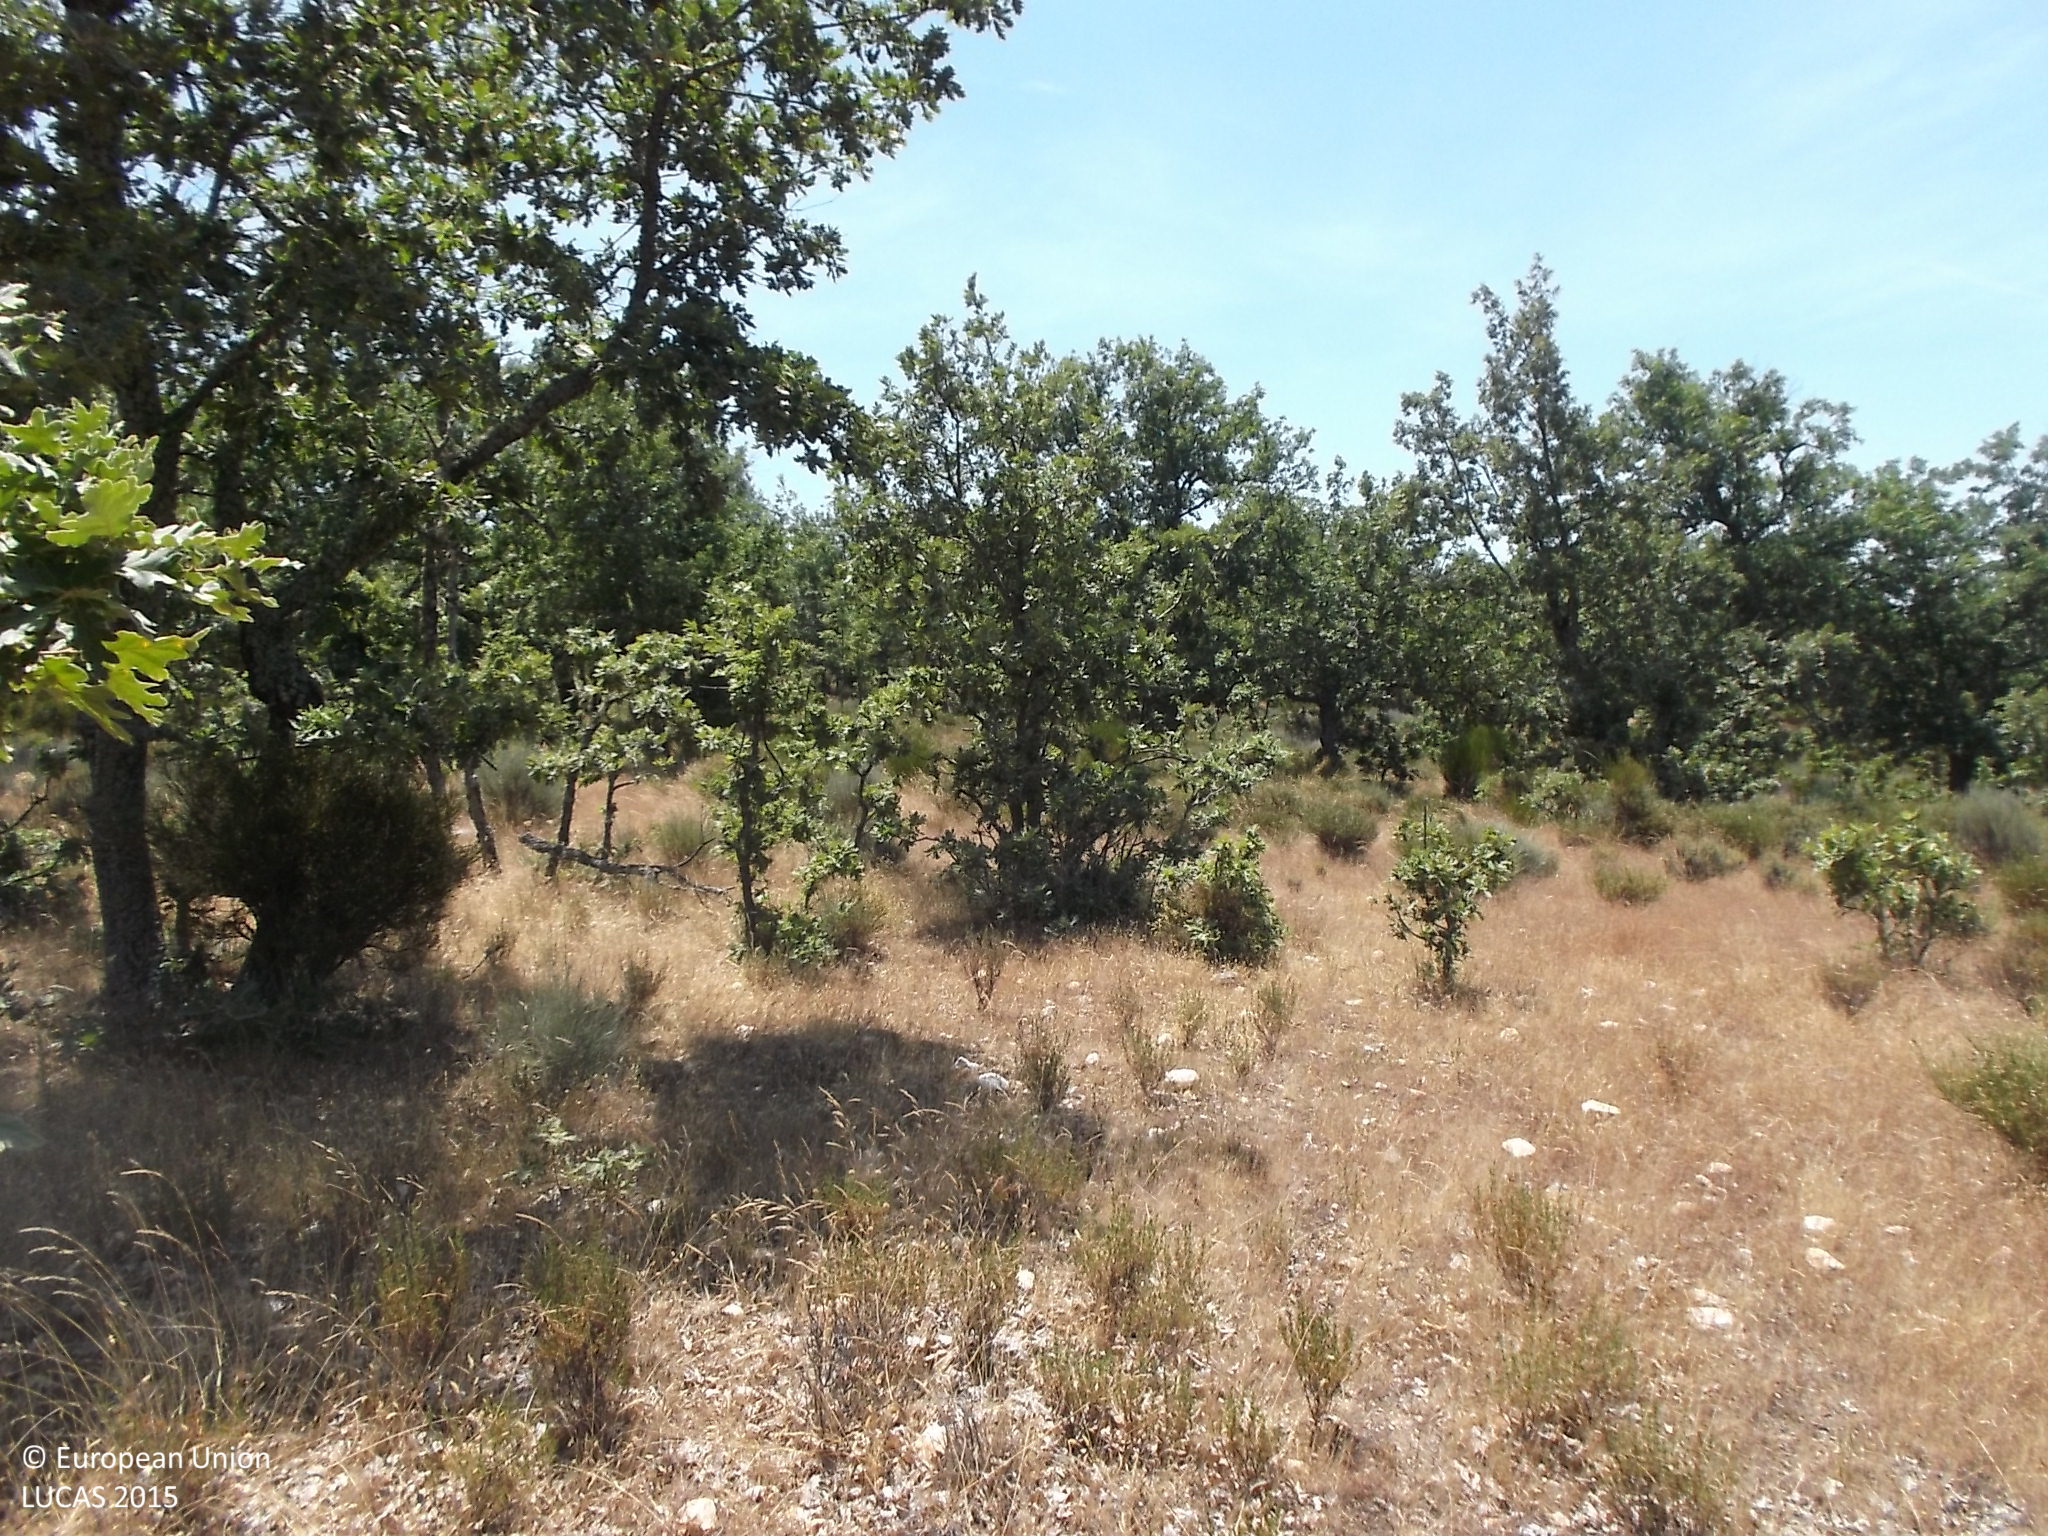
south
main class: Woodland
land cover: Broadleaved woodland
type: broadleaved evergreen forest
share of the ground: 25 - 50 %
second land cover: Shrubland without tree cover
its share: 25 - 50 %
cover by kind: broadleaved forest trees 40 %, shrubs 30 %, herbaceous plants 30 %
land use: Forestry
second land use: Agriculture (excluding fallow land and kitchen gardens)
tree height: < 5 m
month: July
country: ES
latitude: 41.2418
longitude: -6.4570
